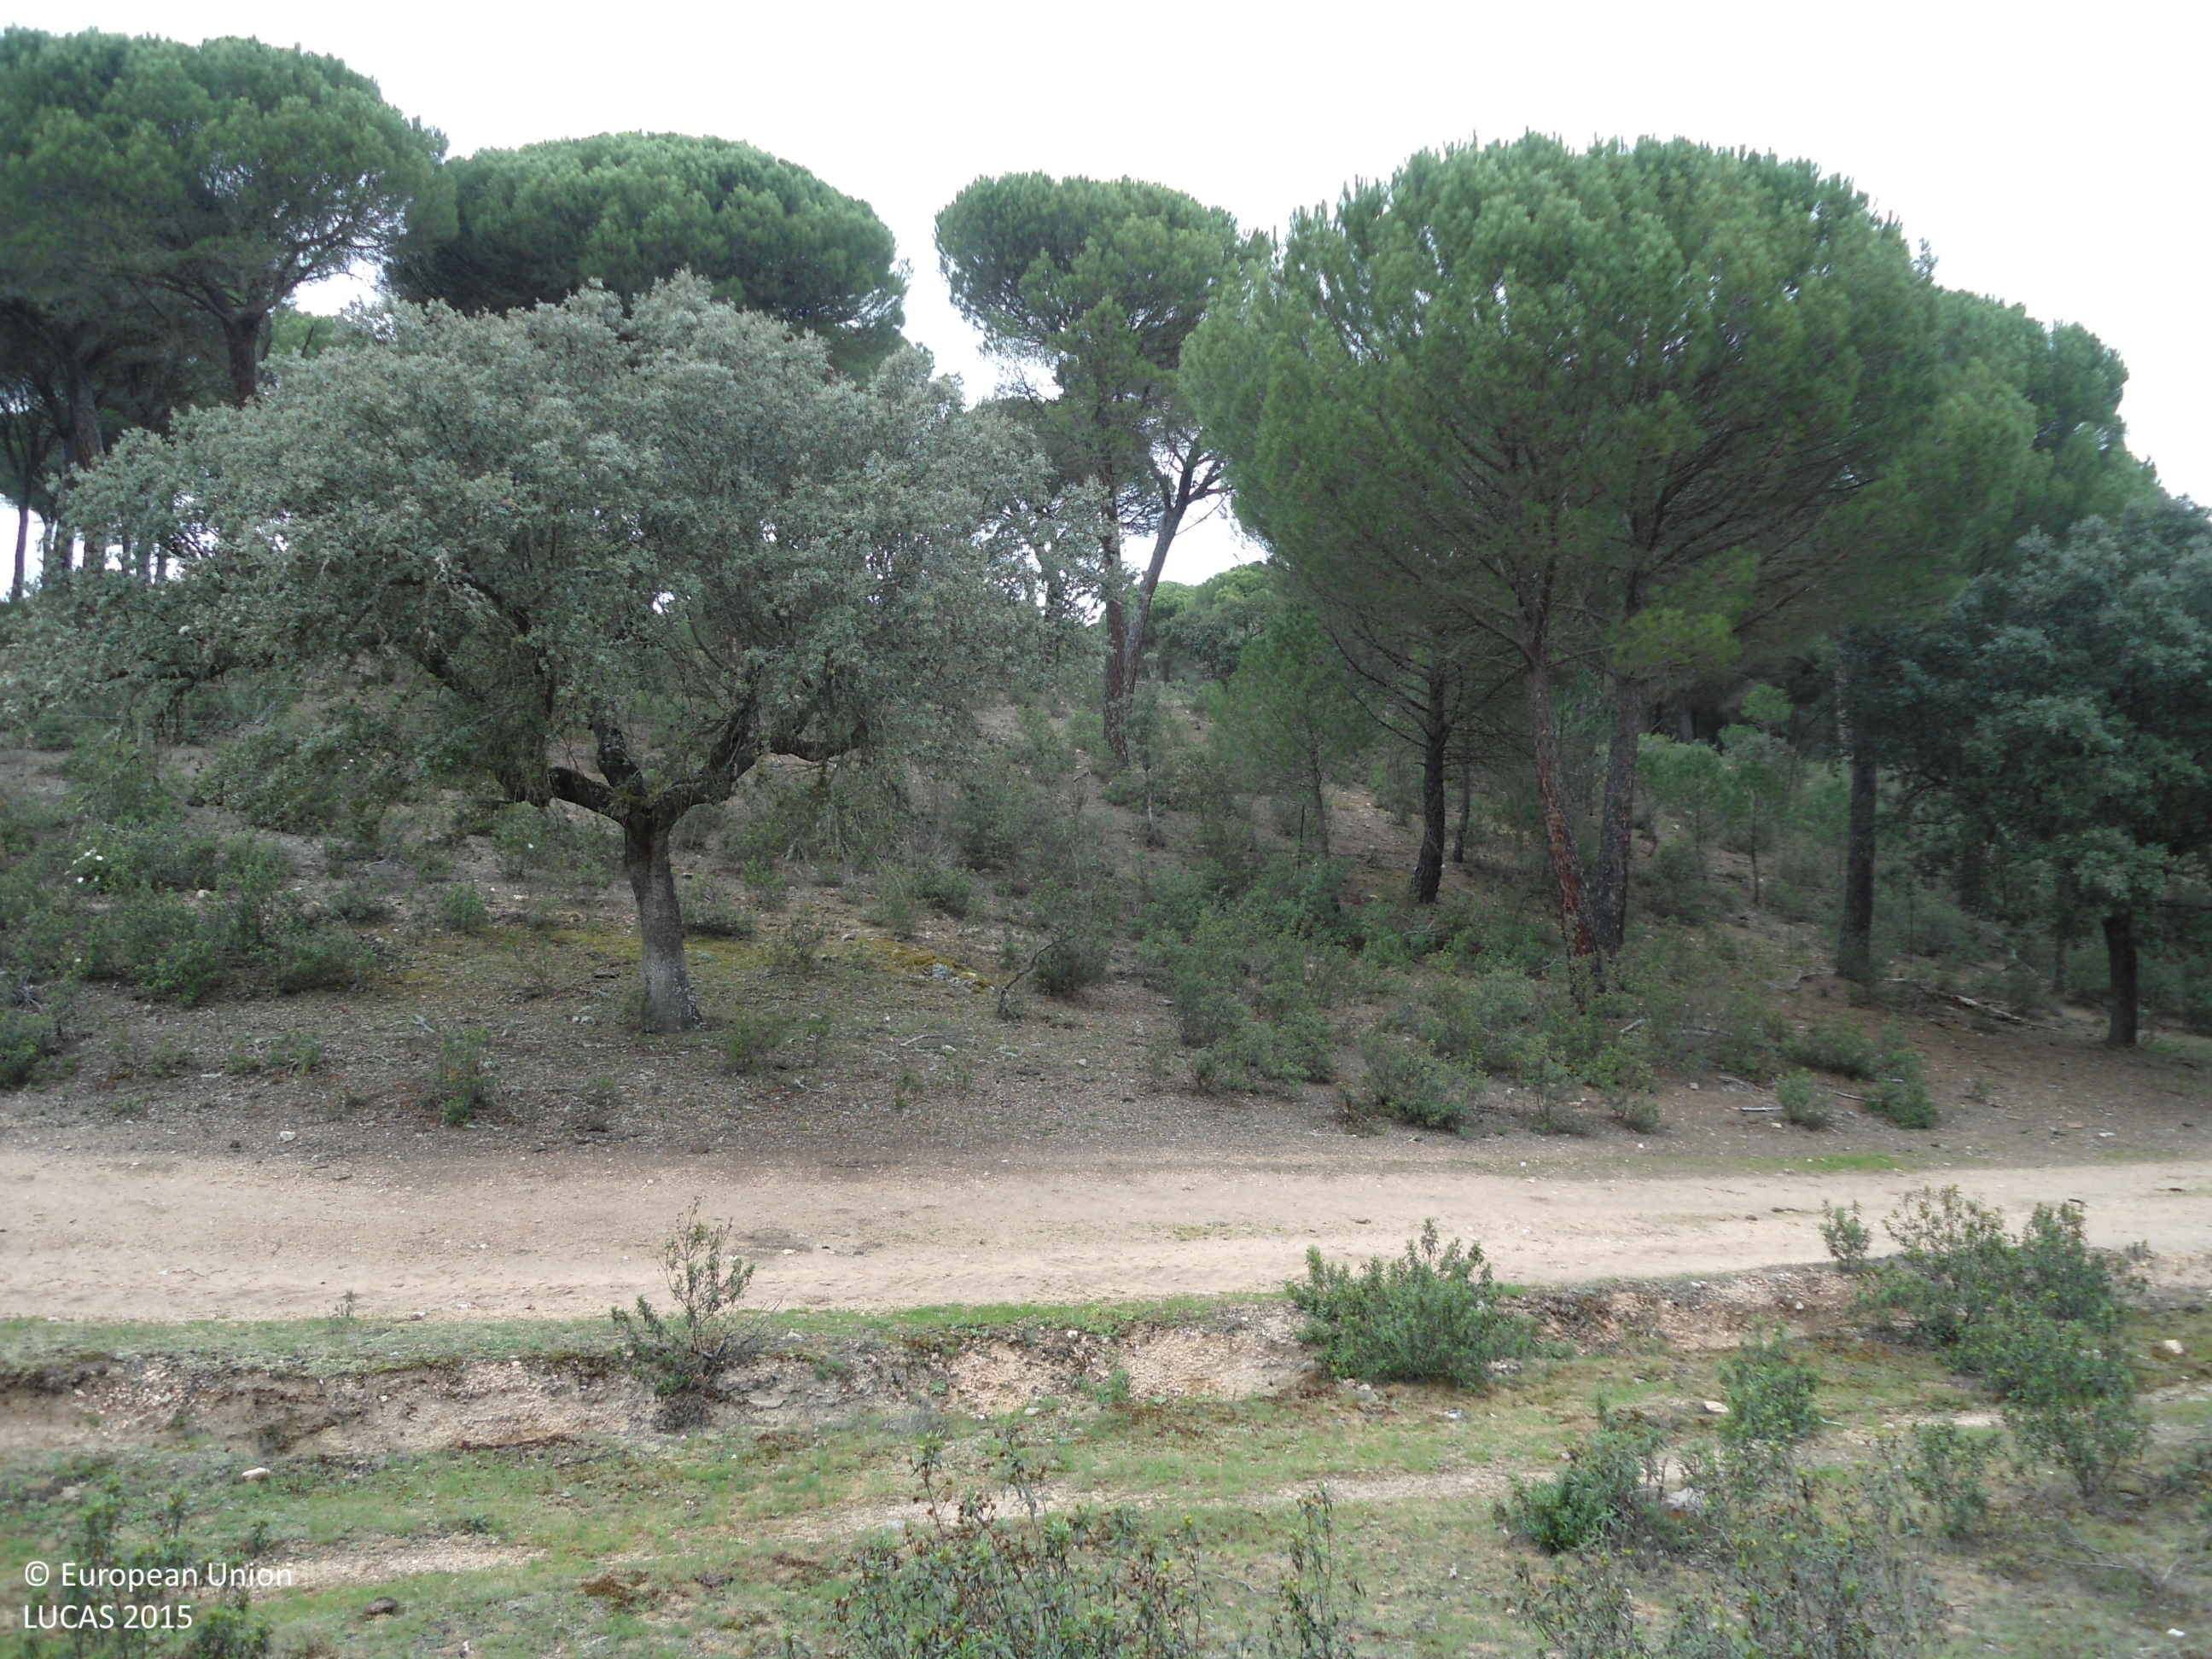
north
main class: Woodland
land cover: Pine dominated coniferous woodland
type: coniferous forest of the mediterranean region
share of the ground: > 75 %
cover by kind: coniferous forest trees 80 %, shrubs 10 %, herbaceous plants 10 %
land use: Agriculture (excluding fallow land and kitchen gardens)
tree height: > 5 m
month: April
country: ES
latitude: 41.5470
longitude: -5.8292
